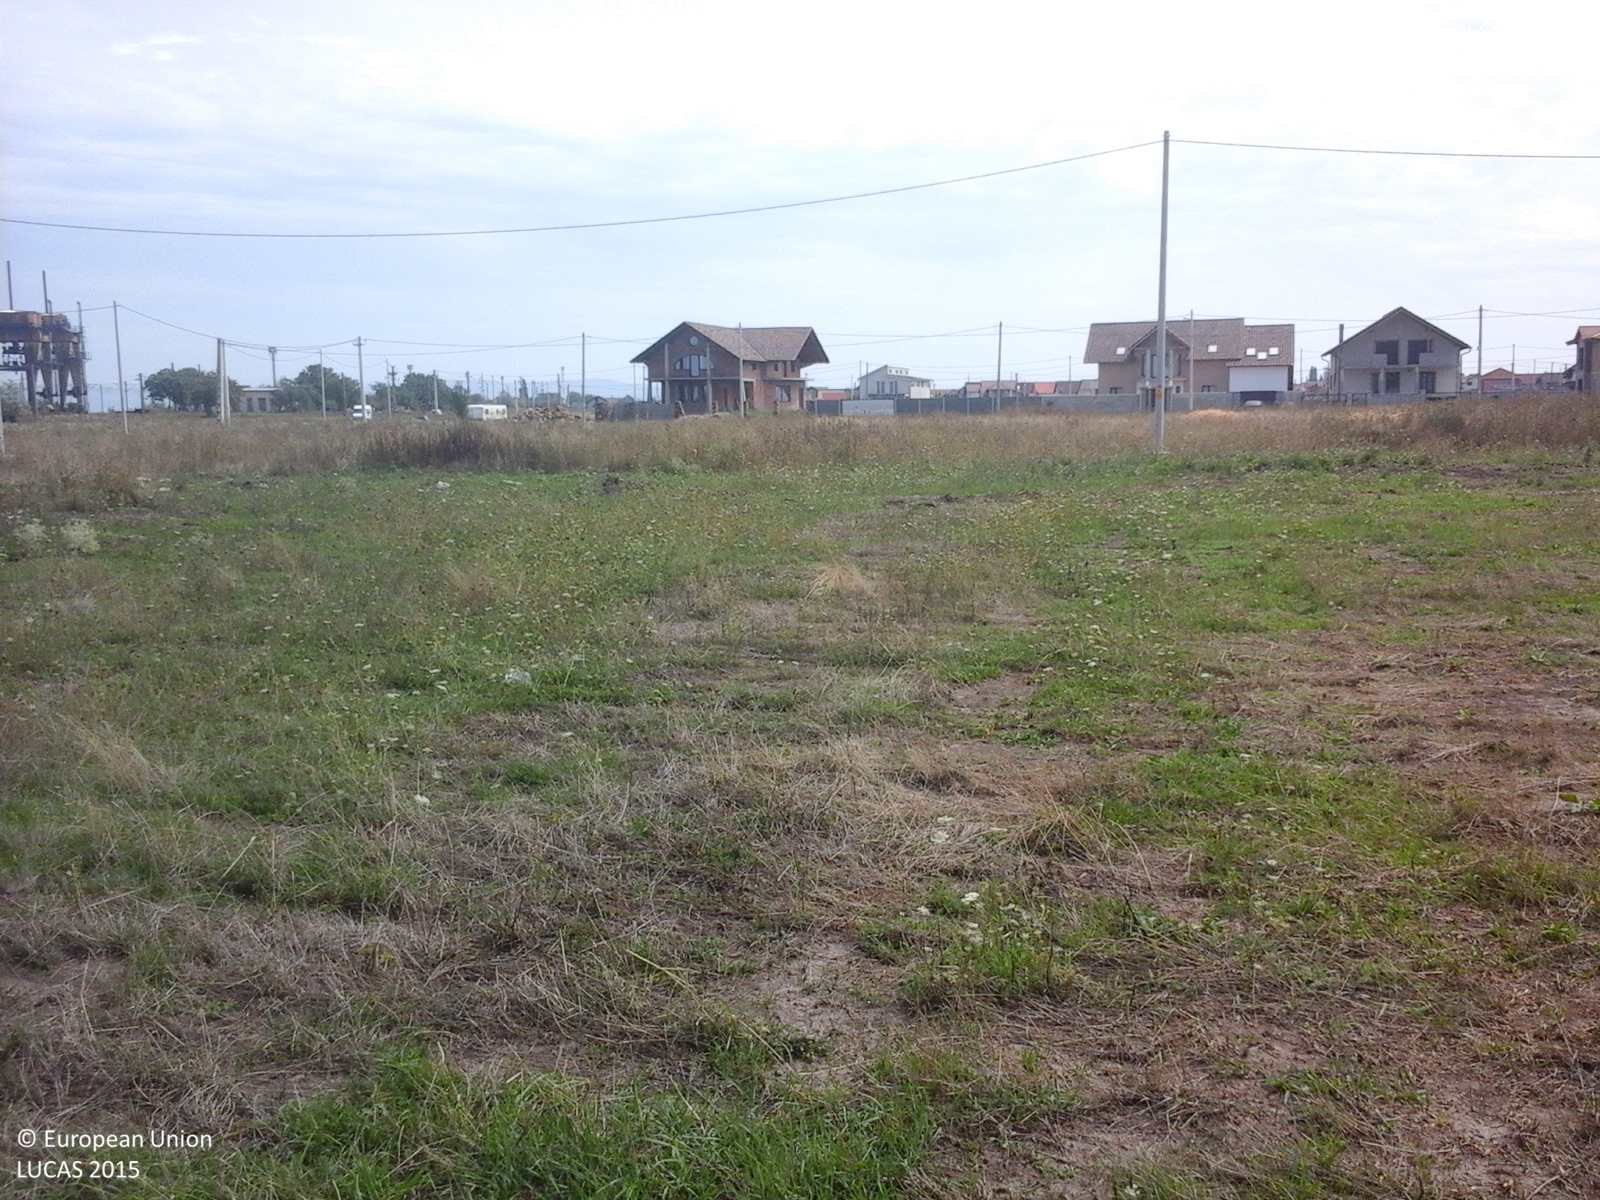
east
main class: Grassland
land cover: Grassland without tree/shrub cover
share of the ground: > 75 %
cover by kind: herbaceous plants 100 %
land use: Agriculture (excluding fallow land and kitchen gardens)
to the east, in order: Grassland without tree/shrub cover; Tracks; Grass margins; Electric lines; Spontaneously vegetated surfaces; Tracks; Grass margins; Electric lines; Spontaneously vegetated surfaces
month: August
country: RO
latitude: 46.1765
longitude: 21.3952
